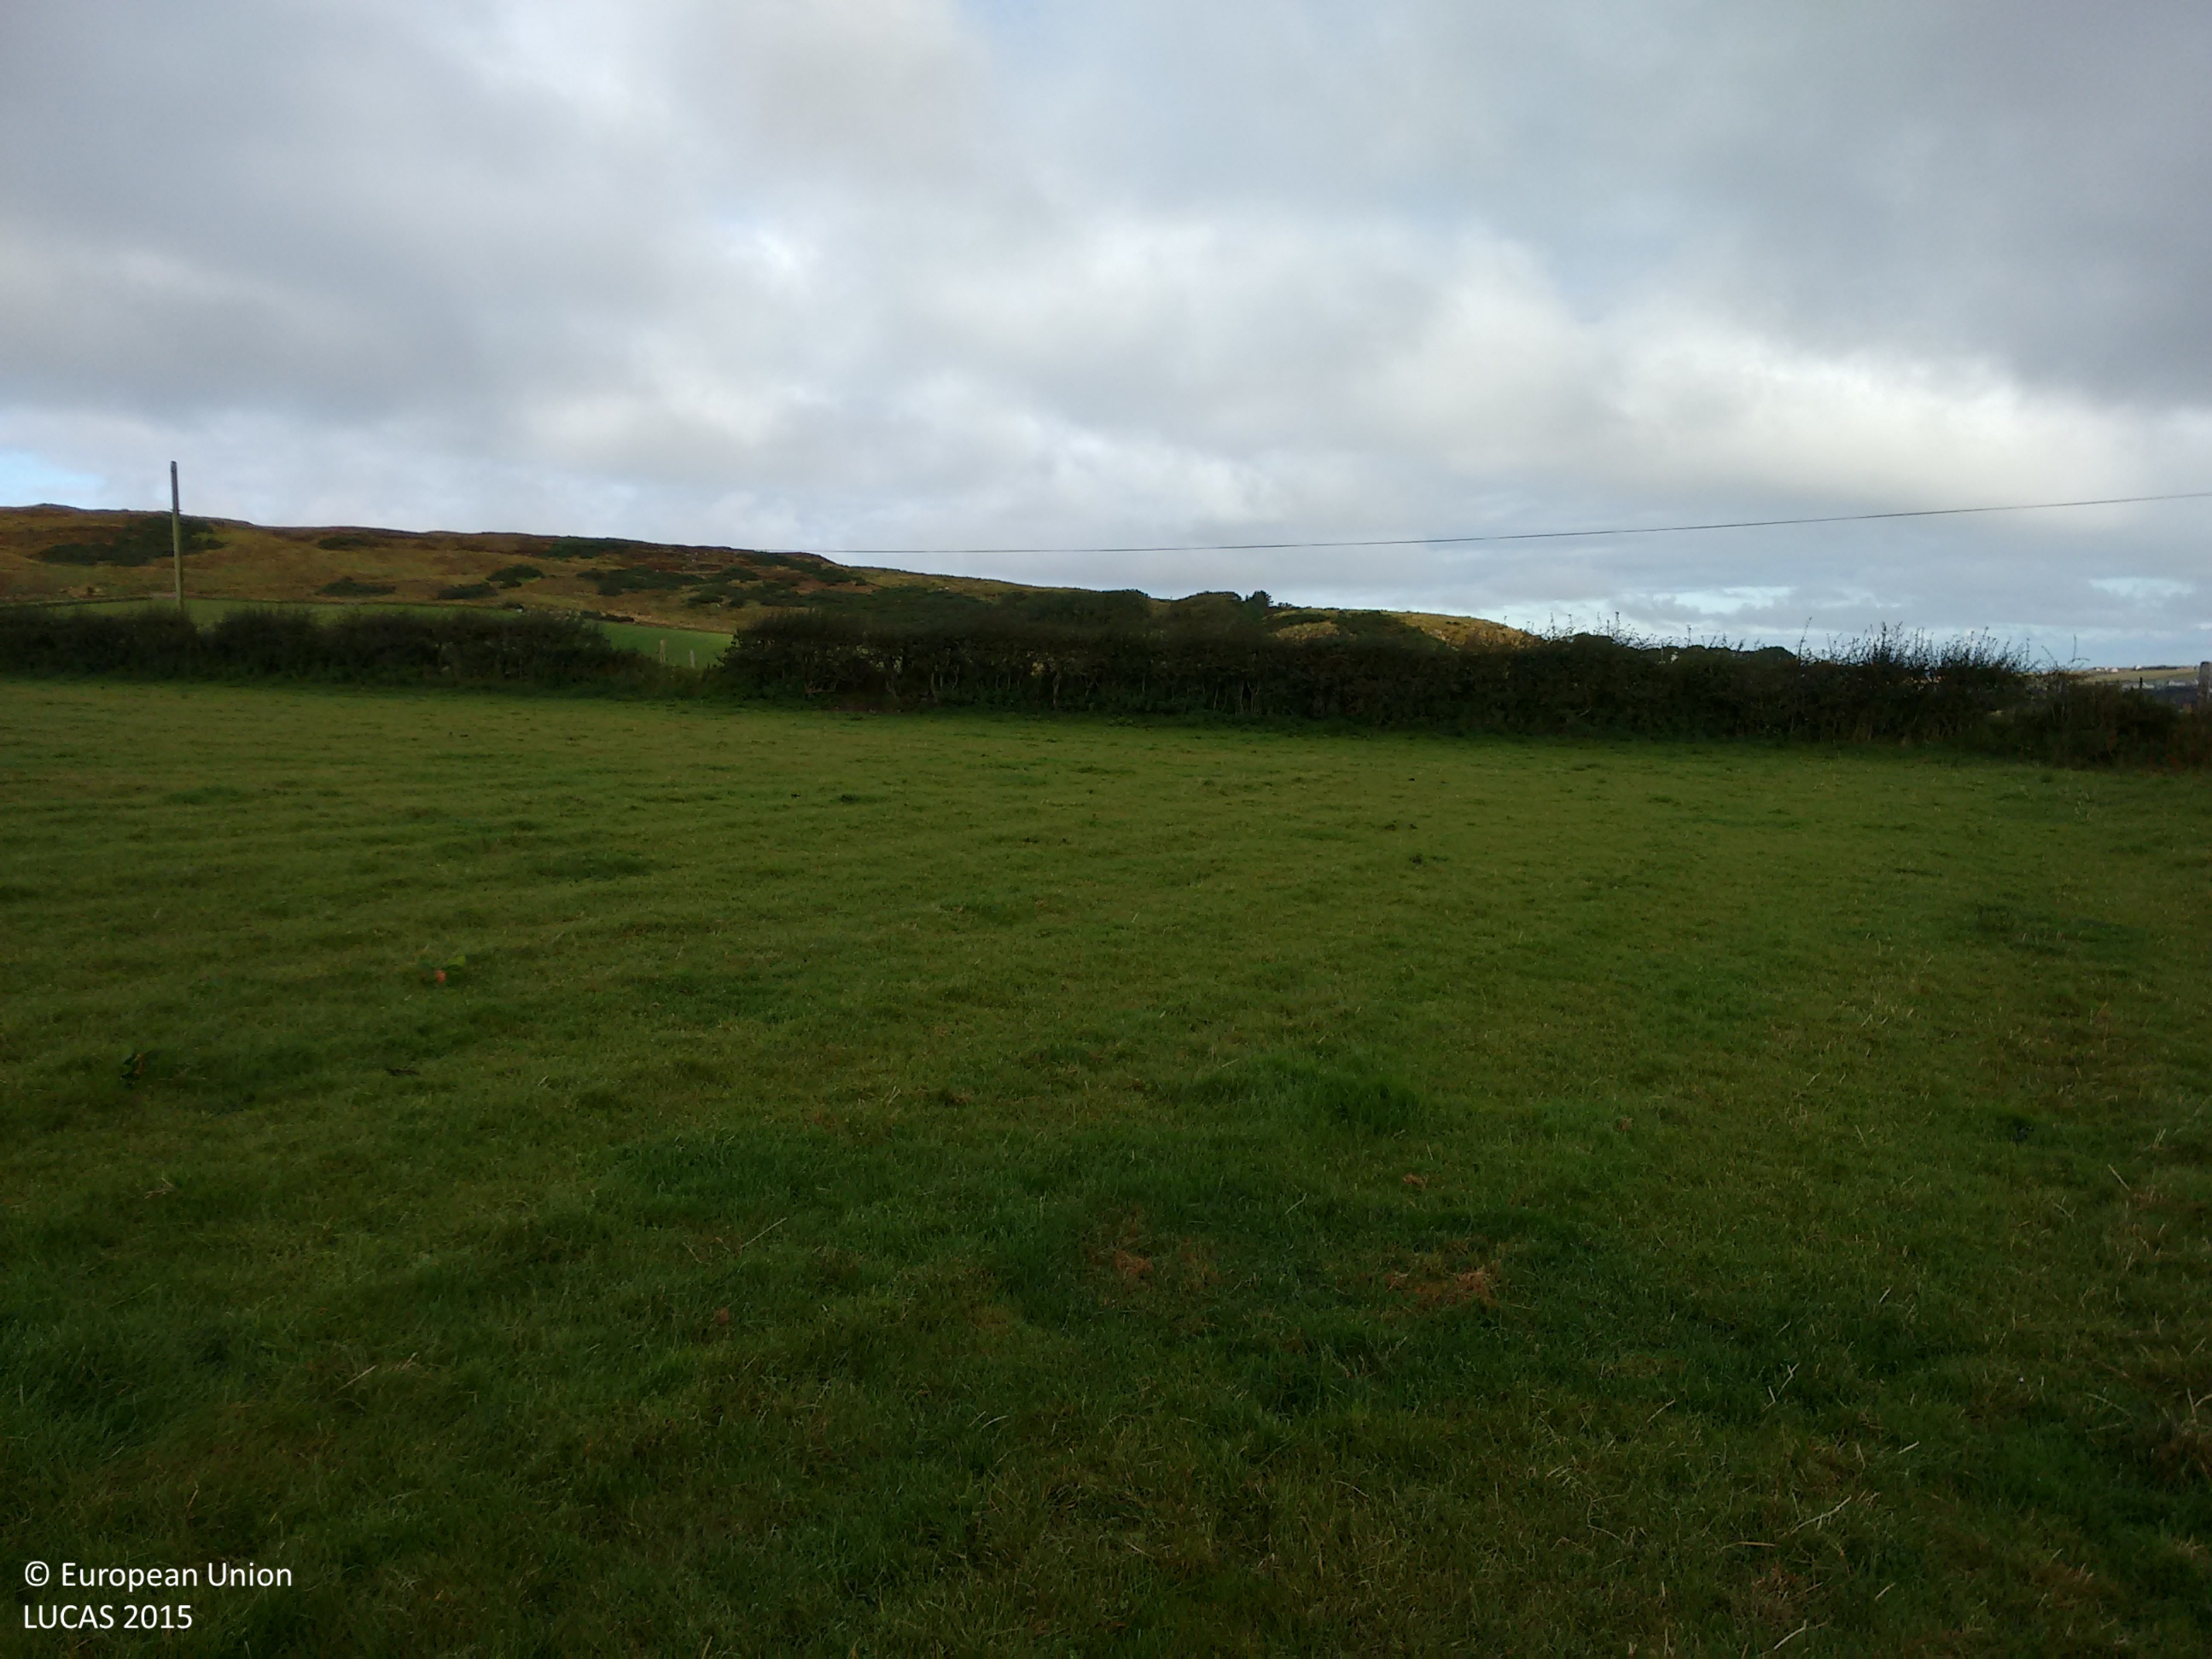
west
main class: Grassland
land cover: Grassland without tree/shrub cover
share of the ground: > 75 %
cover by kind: herbaceous plants 100 %
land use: Agriculture (excluding fallow land and kitchen gardens)
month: September
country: IE
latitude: 55.3290
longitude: -7.3118
